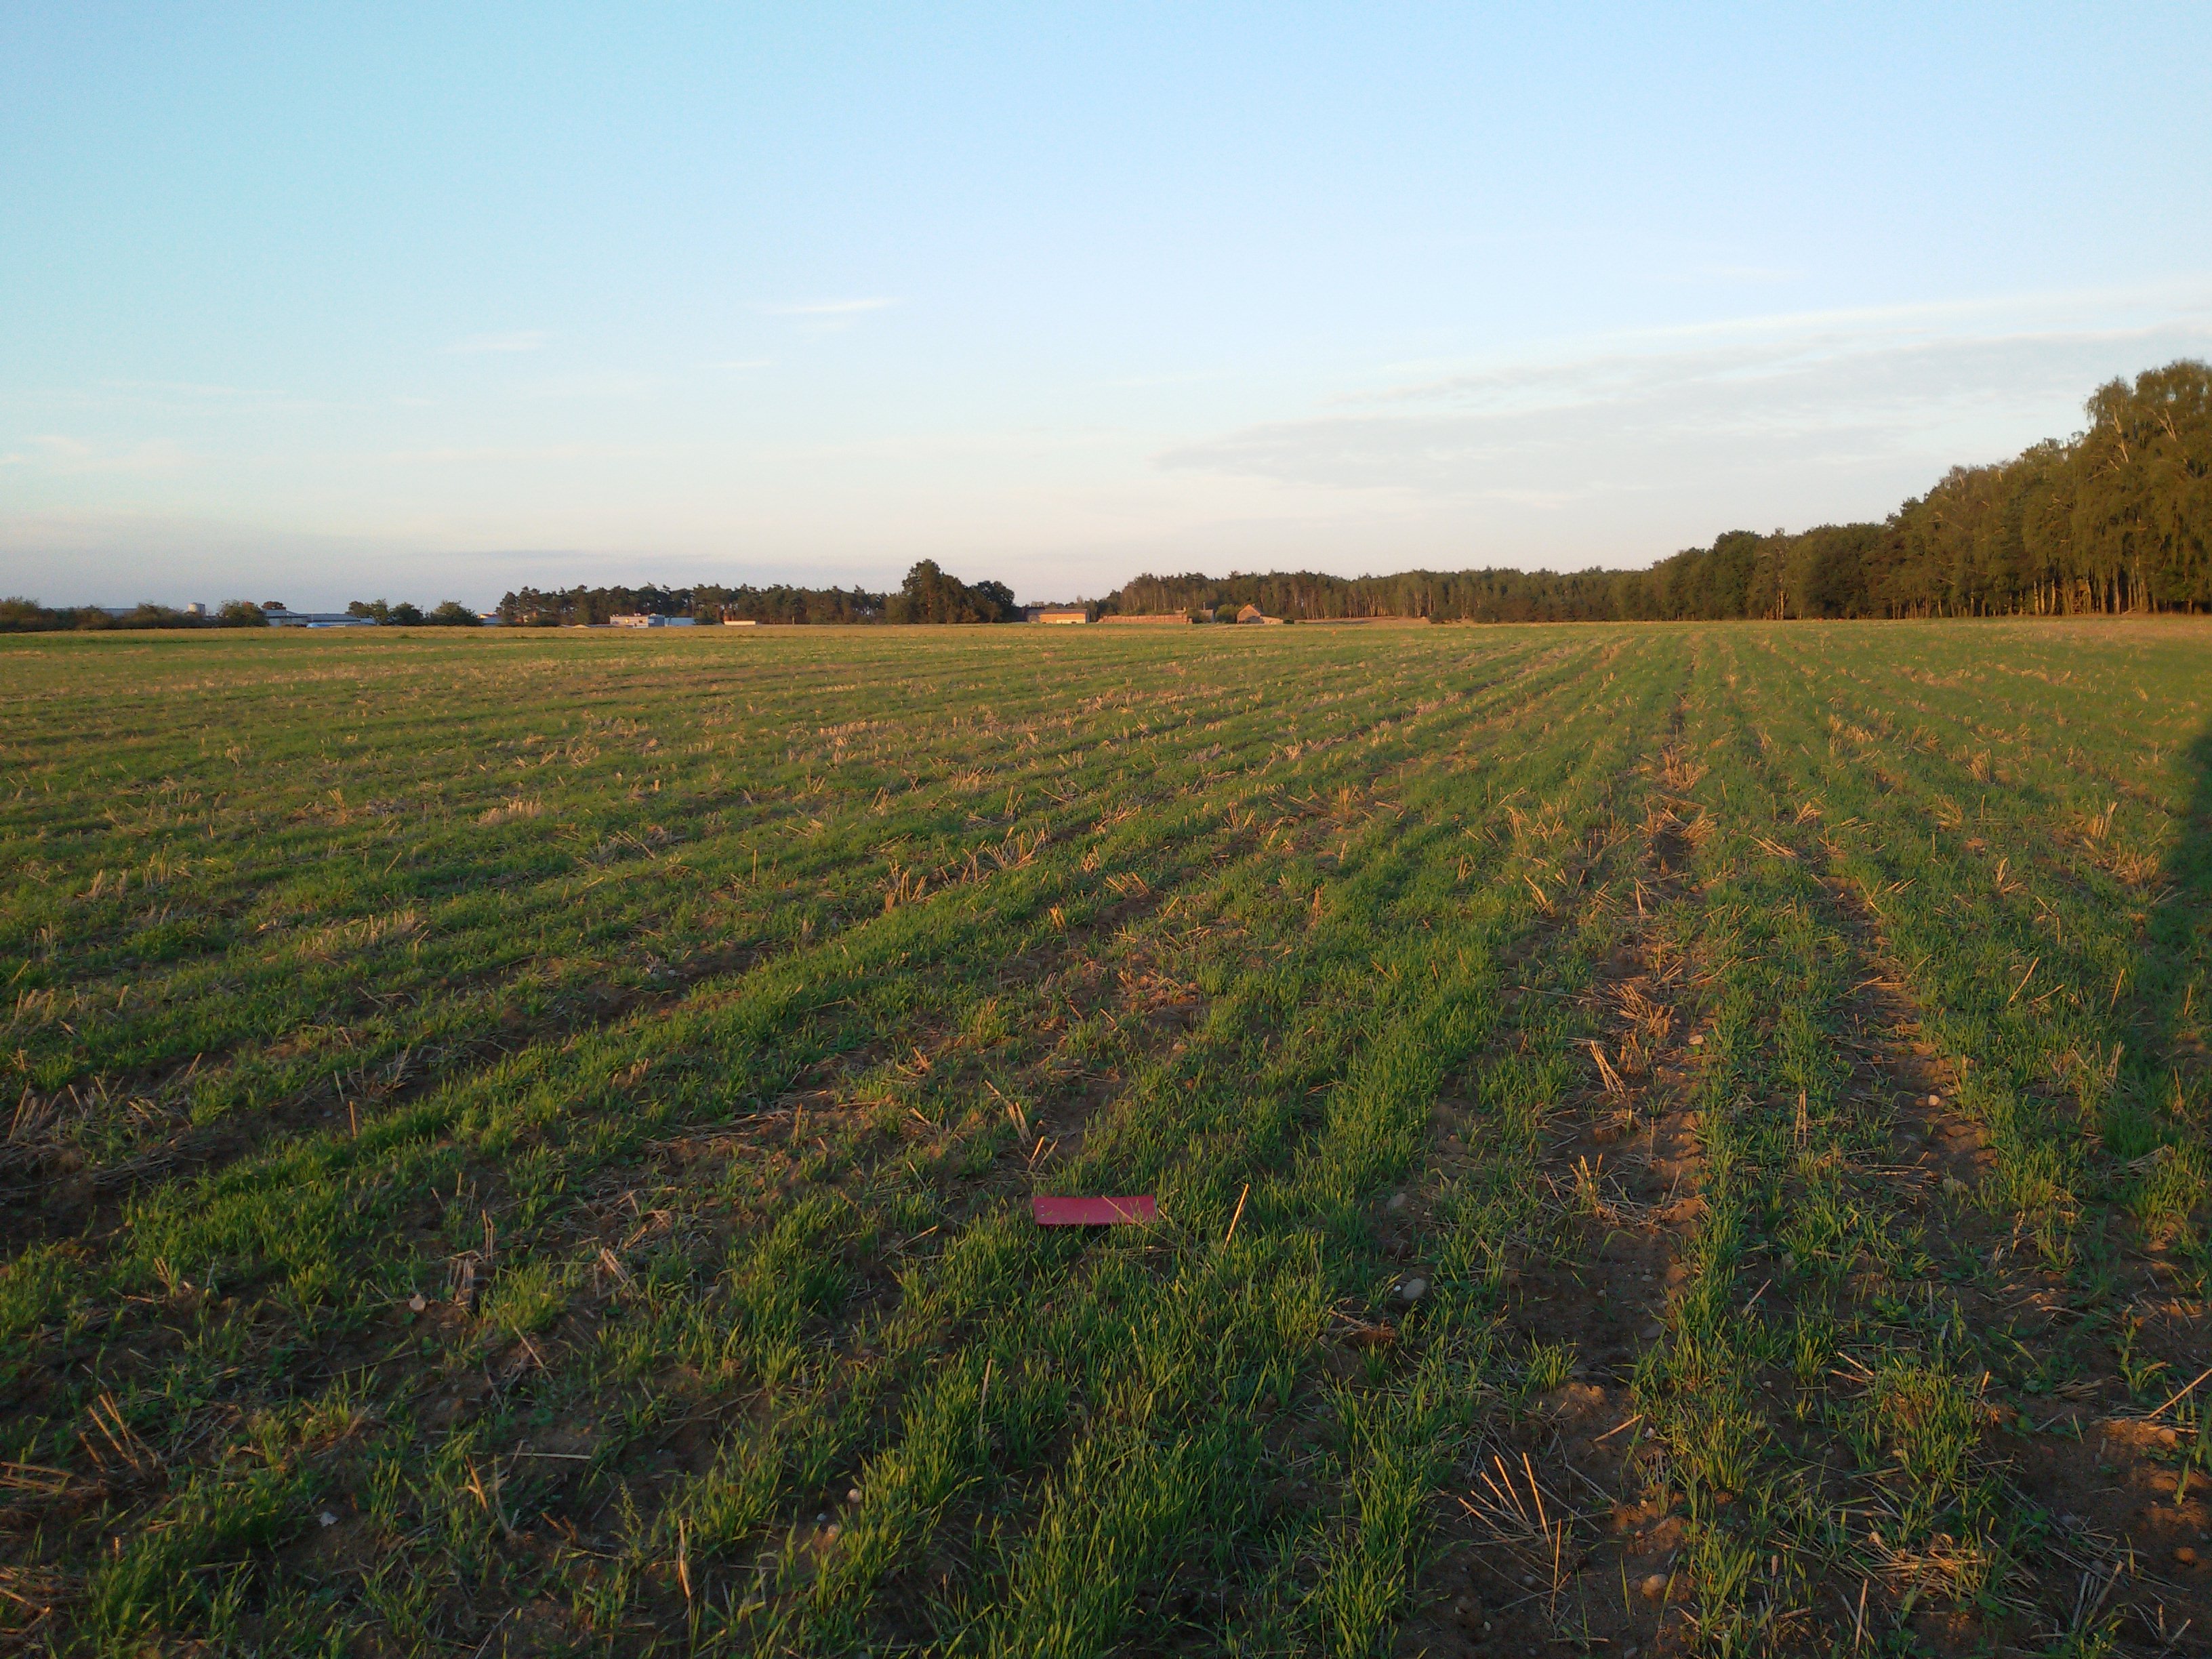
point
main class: Cropland
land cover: Rye
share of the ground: > 75 %
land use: Agriculture (excluding fallow land and kitchen gardens)
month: September
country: PL
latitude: 51.9103
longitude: 16.8269
